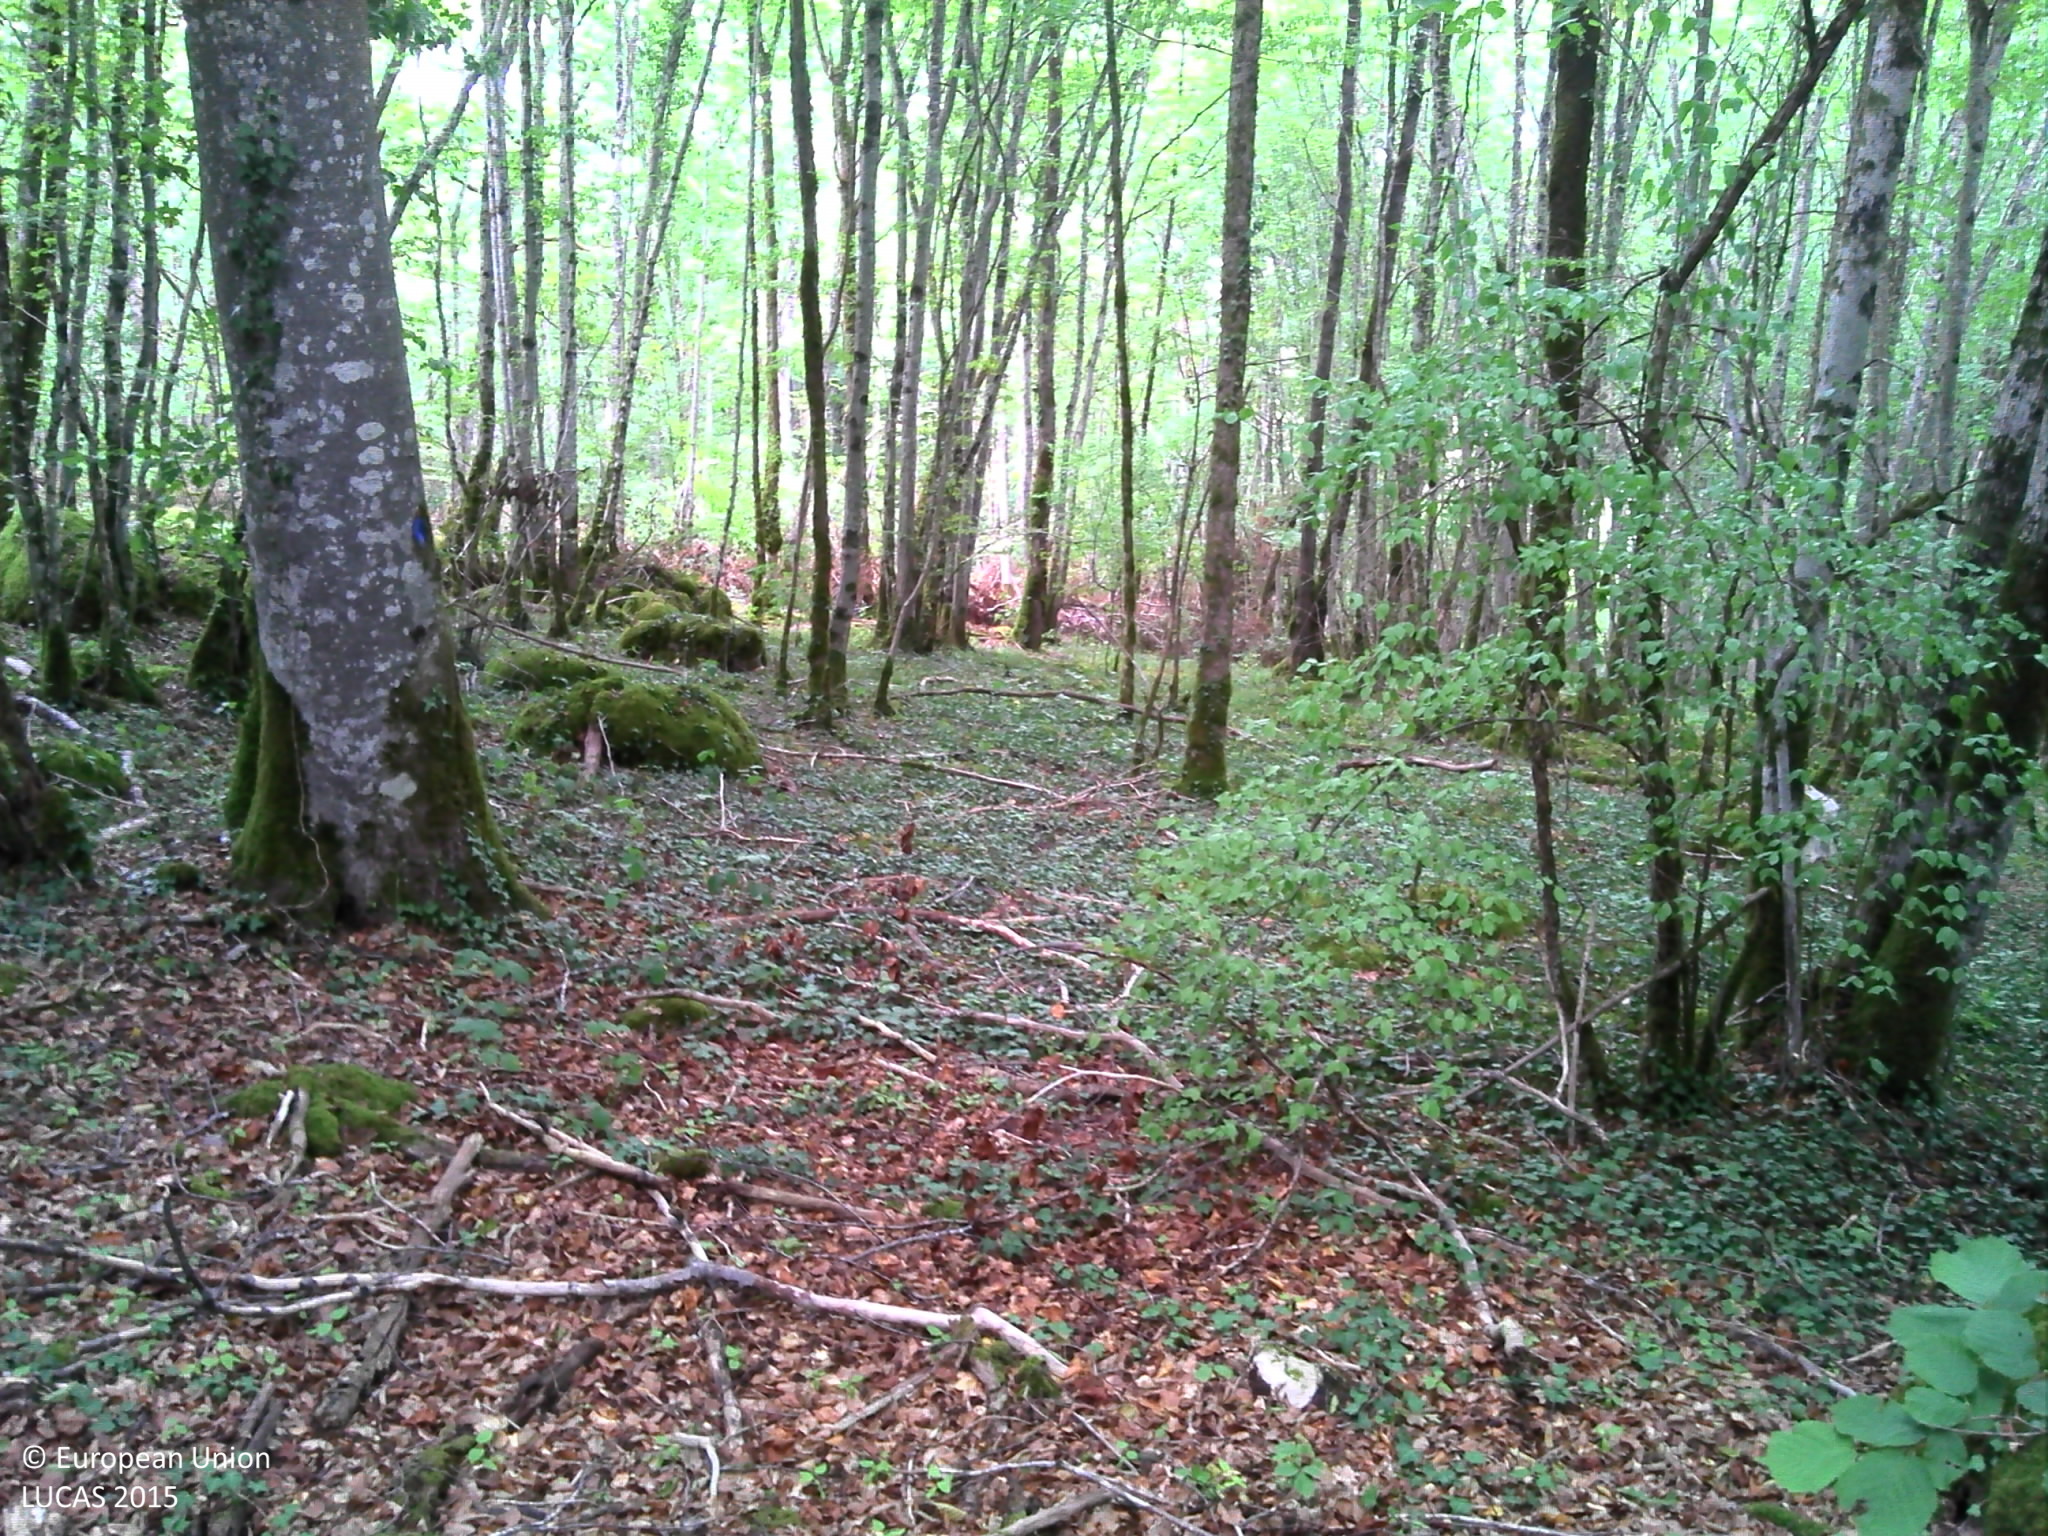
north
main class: Woodland
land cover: Broadleaved woodland
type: beech forest
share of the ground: > 75 %
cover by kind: broadleaved forest trees 90 %, herbaceous plants 5 %, lichens and mosses 5 %
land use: Forestry
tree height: > 5 m
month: August
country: FR
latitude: 47.7625
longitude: 4.8895
